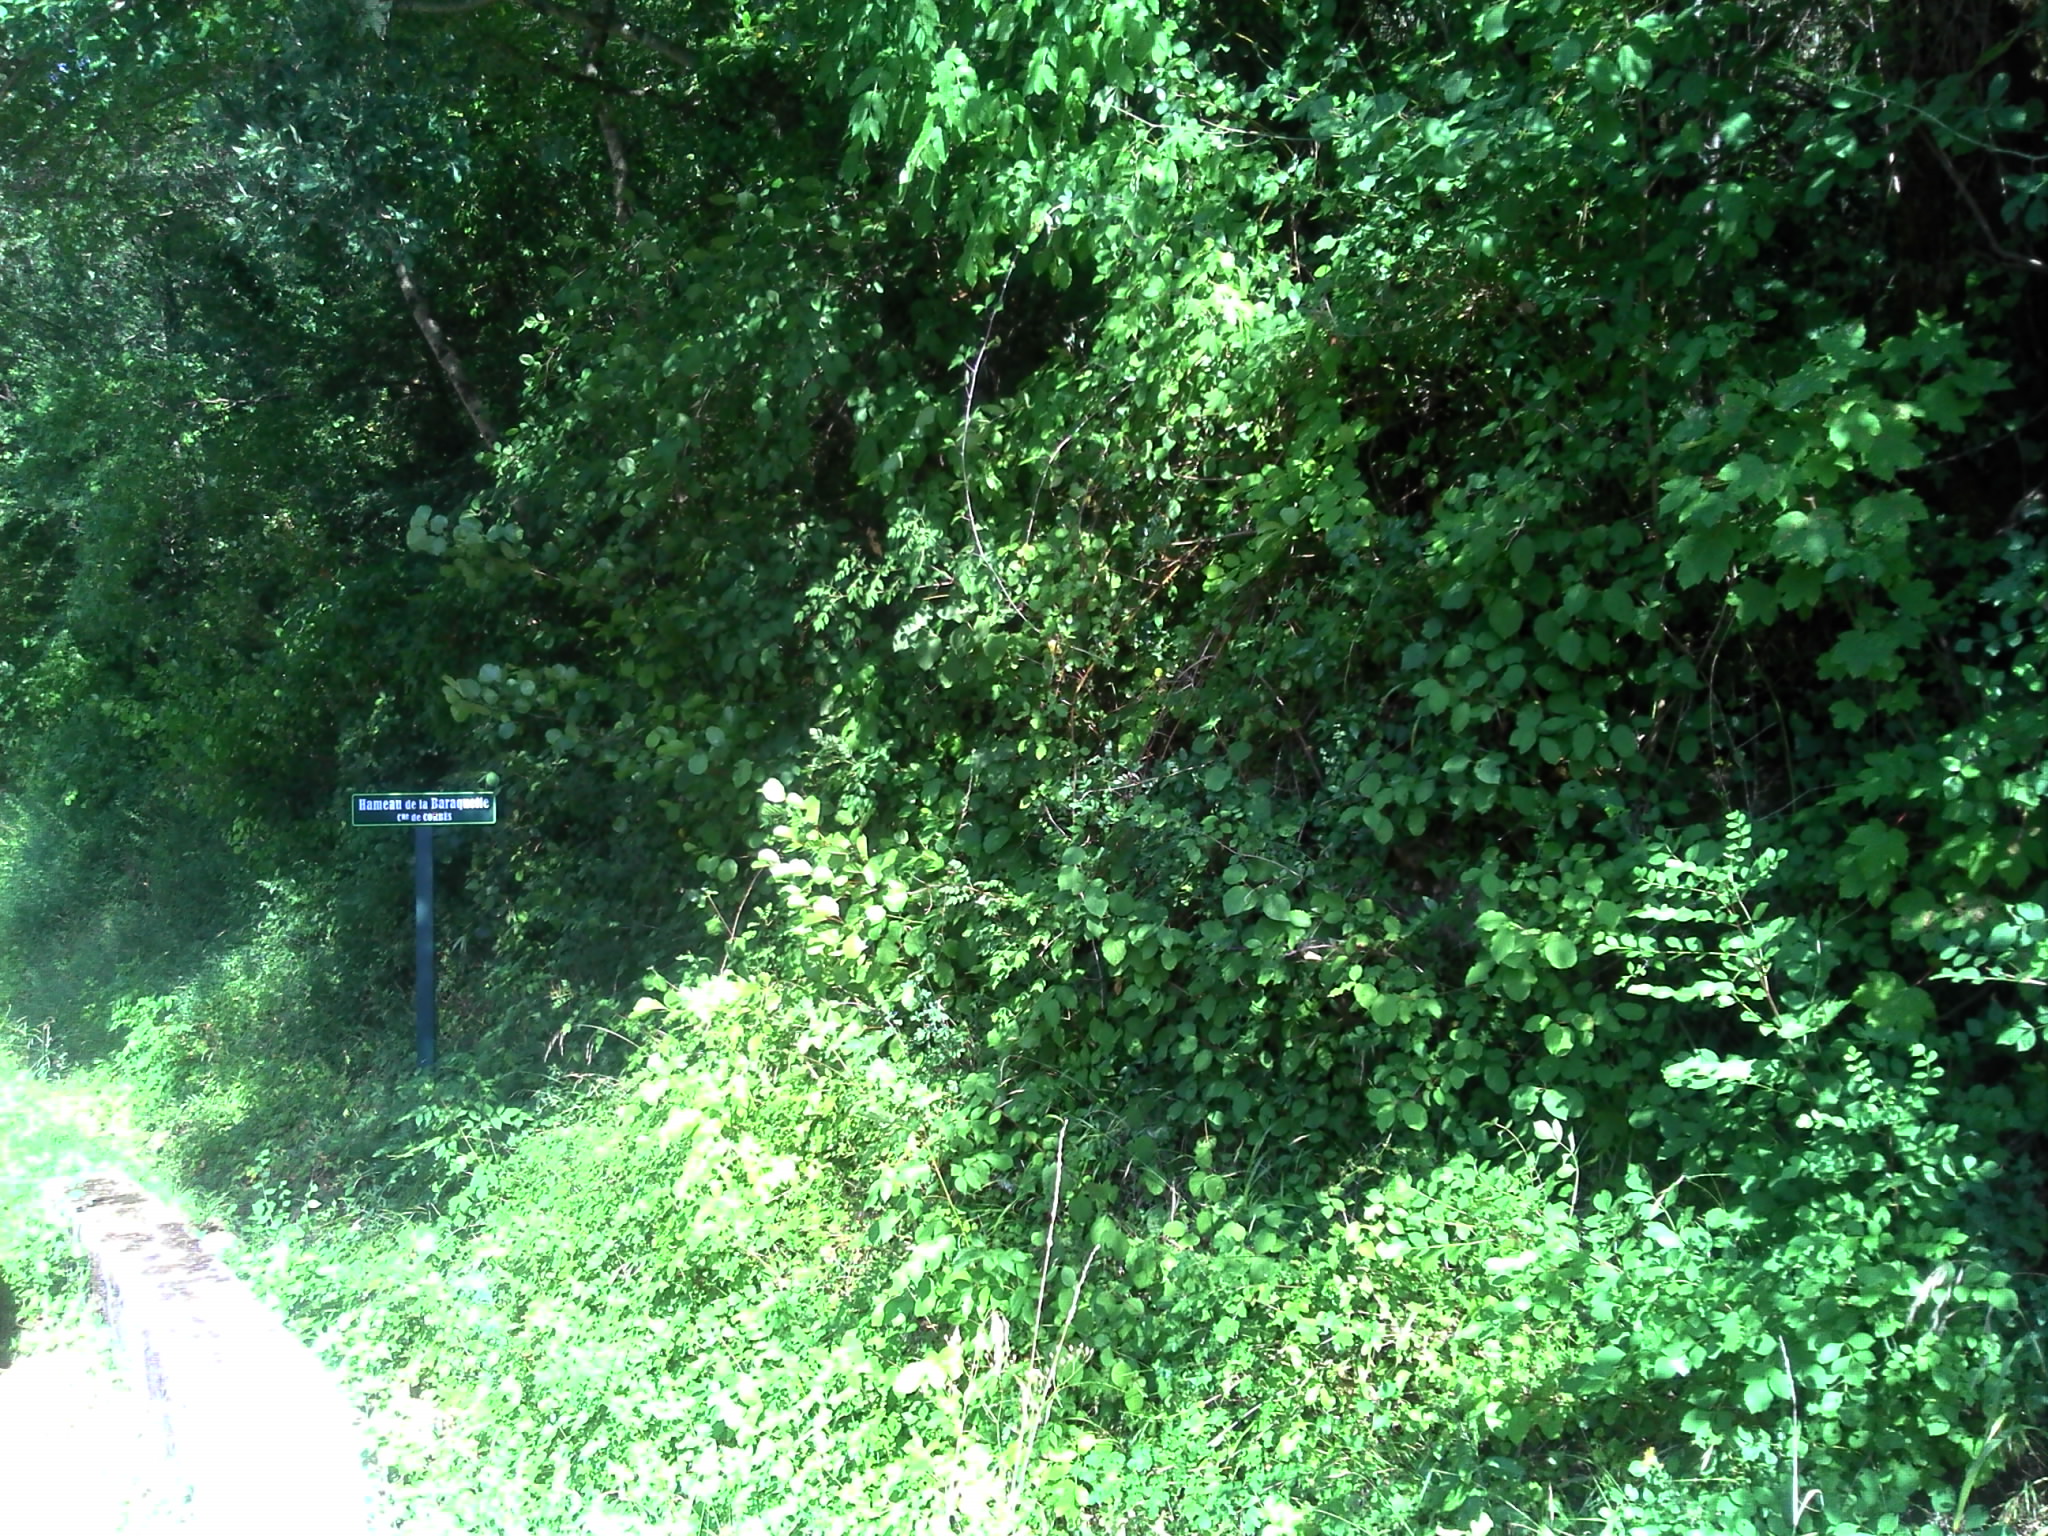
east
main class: Woodland
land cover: Broadleaved woodland
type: broadleaved evergreen forest
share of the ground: > 75 %
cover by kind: broadleaved forest trees 90 %, herbaceous plants 10 %
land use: Forestry
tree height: > 5 m
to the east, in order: Broadleaved woodland
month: July
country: FR
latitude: 44.0656
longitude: 3.9525
